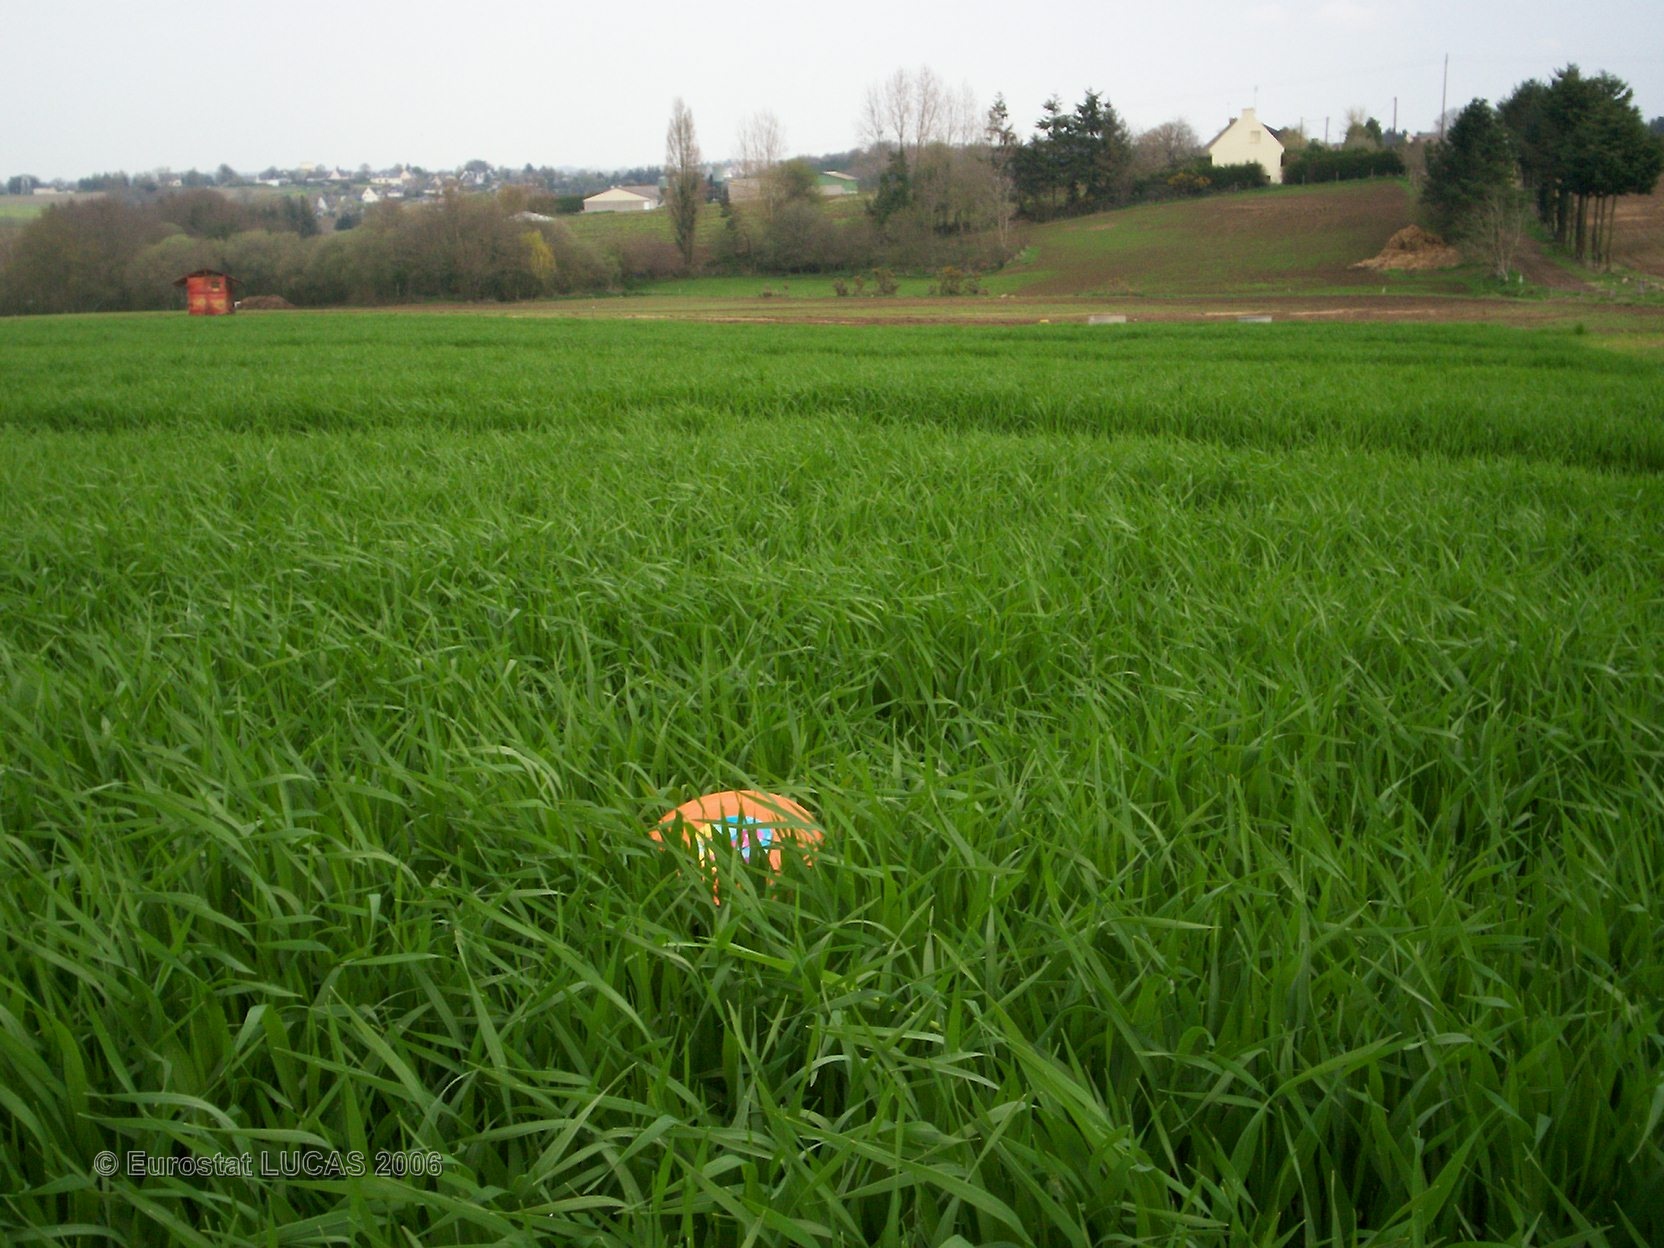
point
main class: Cropland
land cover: Barley
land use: Agriculture (excluding fallow land and kitchen gardens)
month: April
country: FR
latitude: 48.0600
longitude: -2.7712
